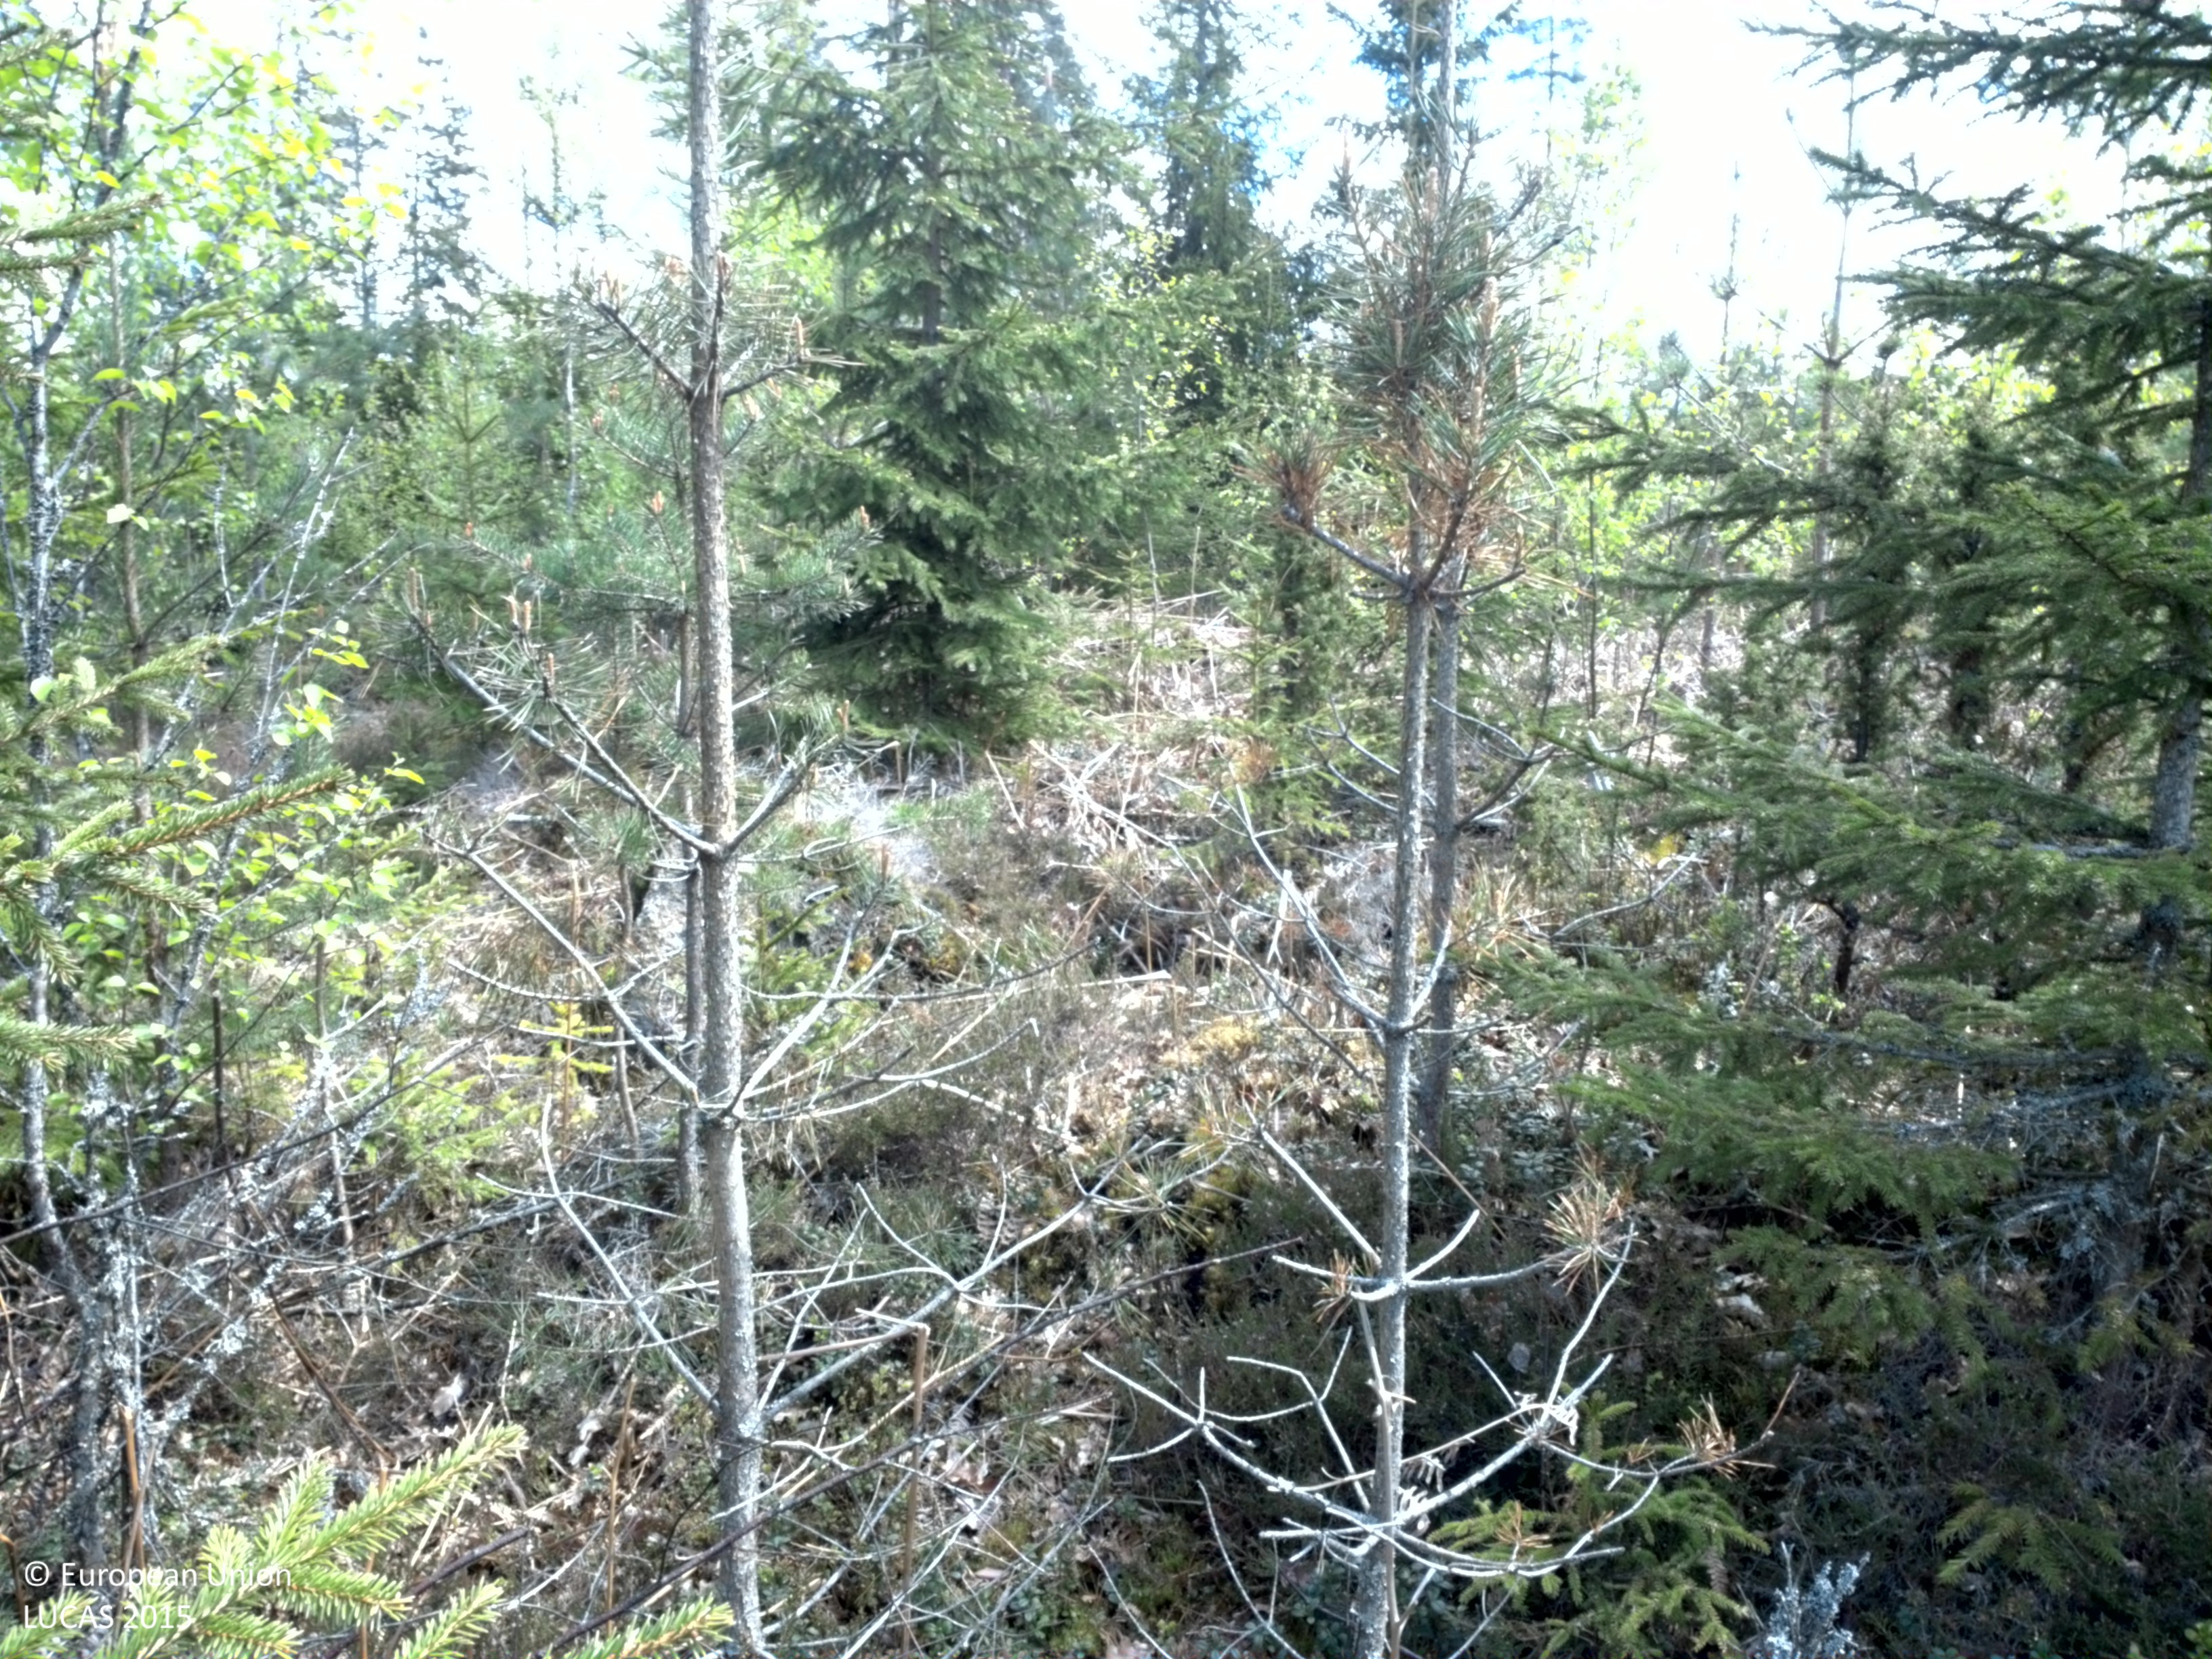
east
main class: Woodland
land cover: Spruce dominated mixed woodland
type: boreal forest
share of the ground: > 75 %
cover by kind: coniferous forest trees 75 %, broadleaved forest trees 25 %
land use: Forestry
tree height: < 5 m
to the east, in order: Spruce dominated mixed woodland; Lichens and moss; Broadleaved woodland; Lichens and moss; Broadleaved woodland; Pine dominated coniferous woodland; Broadleaved woodland; Paved roads, cycling and walking lanes; Artificial constructions in urban areas; Broadleaved woodland
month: May
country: SE
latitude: 56.4539
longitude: 15.3695
